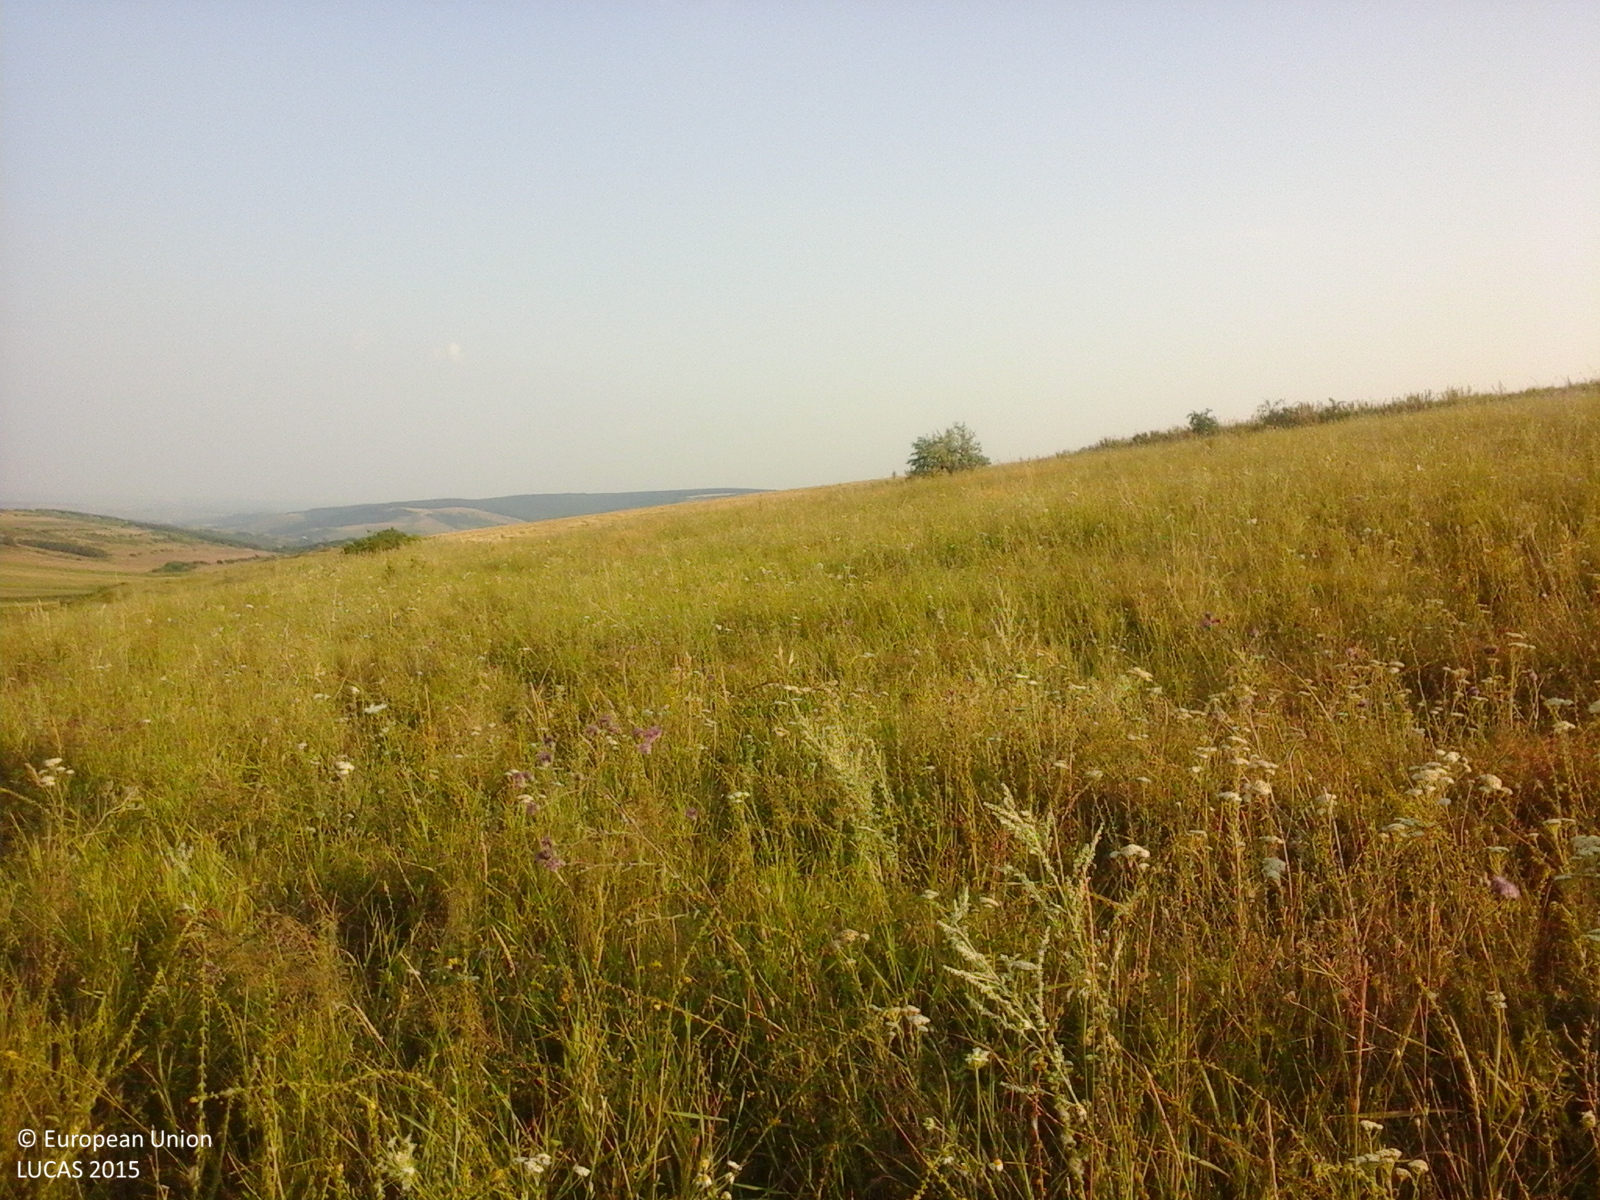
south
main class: Grassland
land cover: Grassland without tree/shrub cover
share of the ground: > 75 %
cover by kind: herbaceous plants 100 %
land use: Agriculture (excluding fallow land and kitchen gardens)
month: July
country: RO
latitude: 46.4217
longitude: 27.6142
